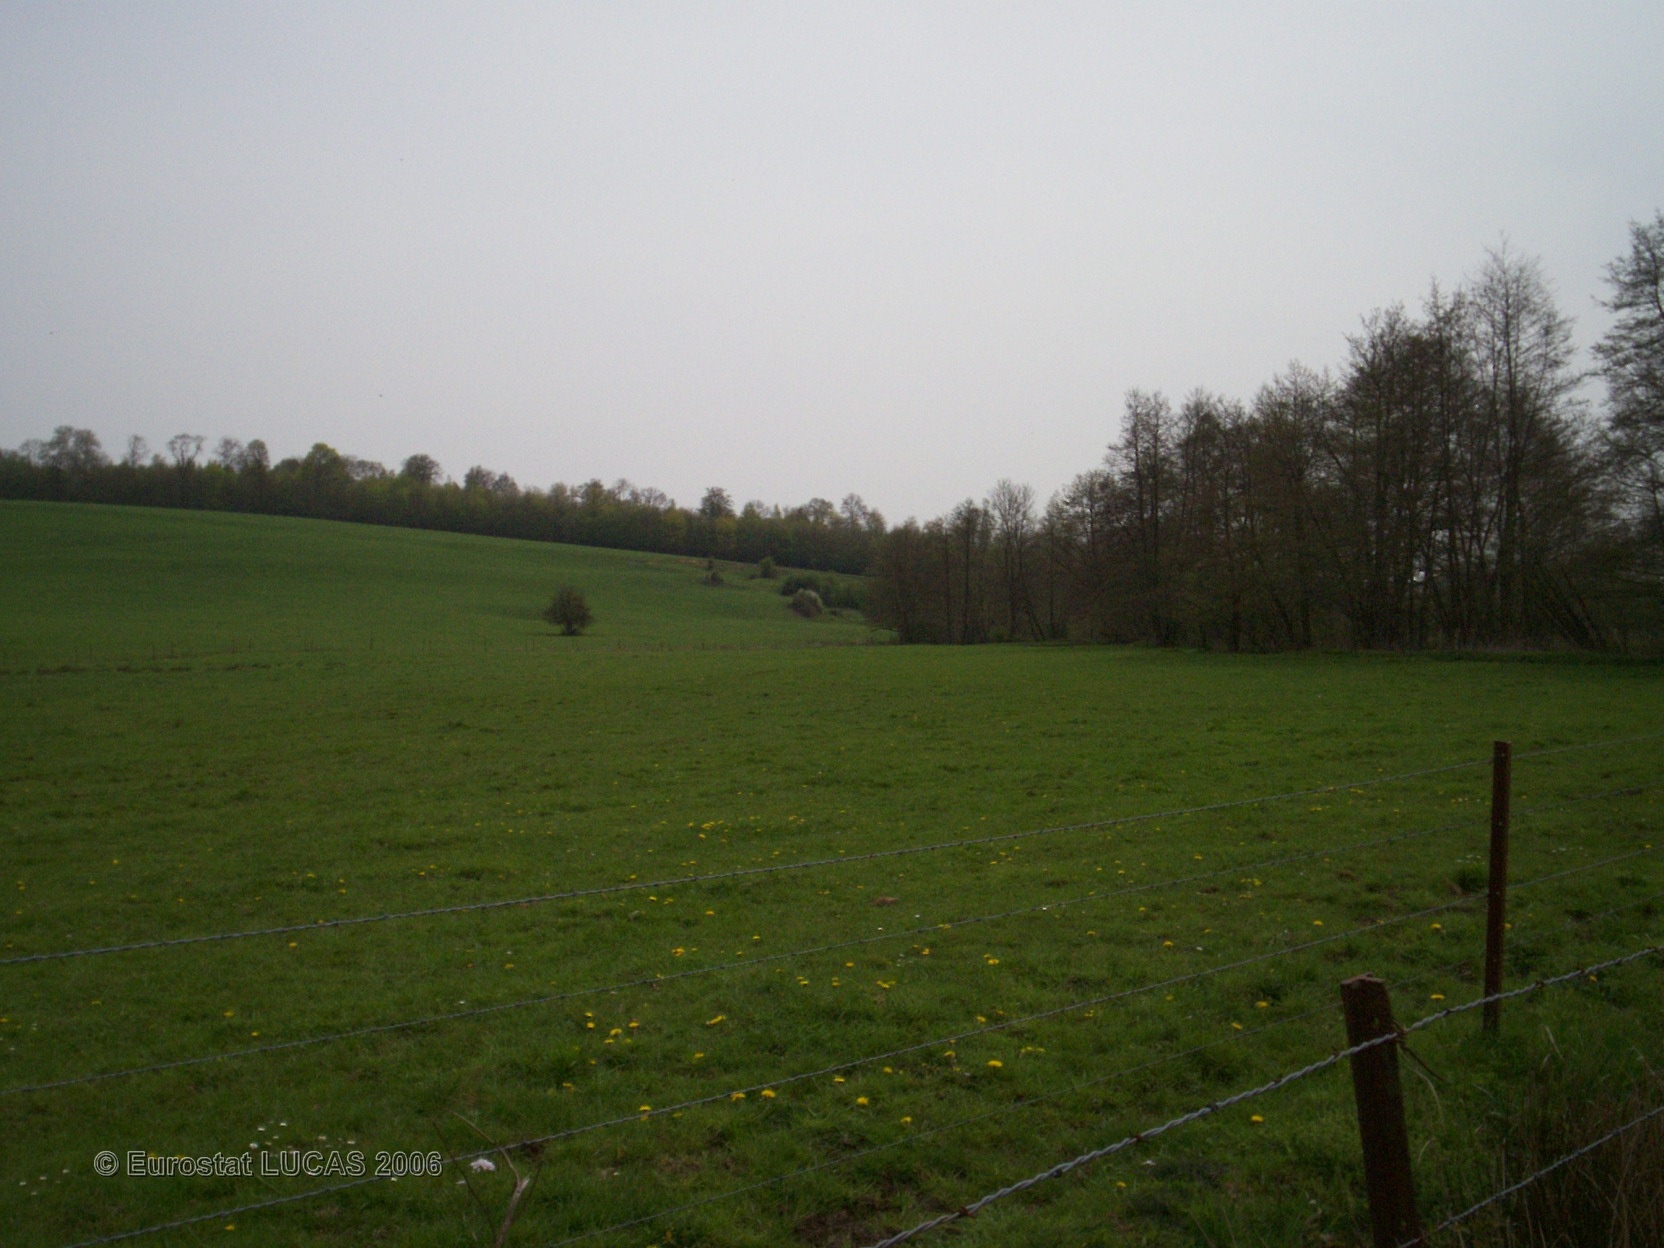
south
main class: Grassland
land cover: Grassland without tree/shrub cover
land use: Agriculture (excluding fallow land and kitchen gardens)
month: May
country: FR
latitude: 49.8659
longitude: 4.3891
